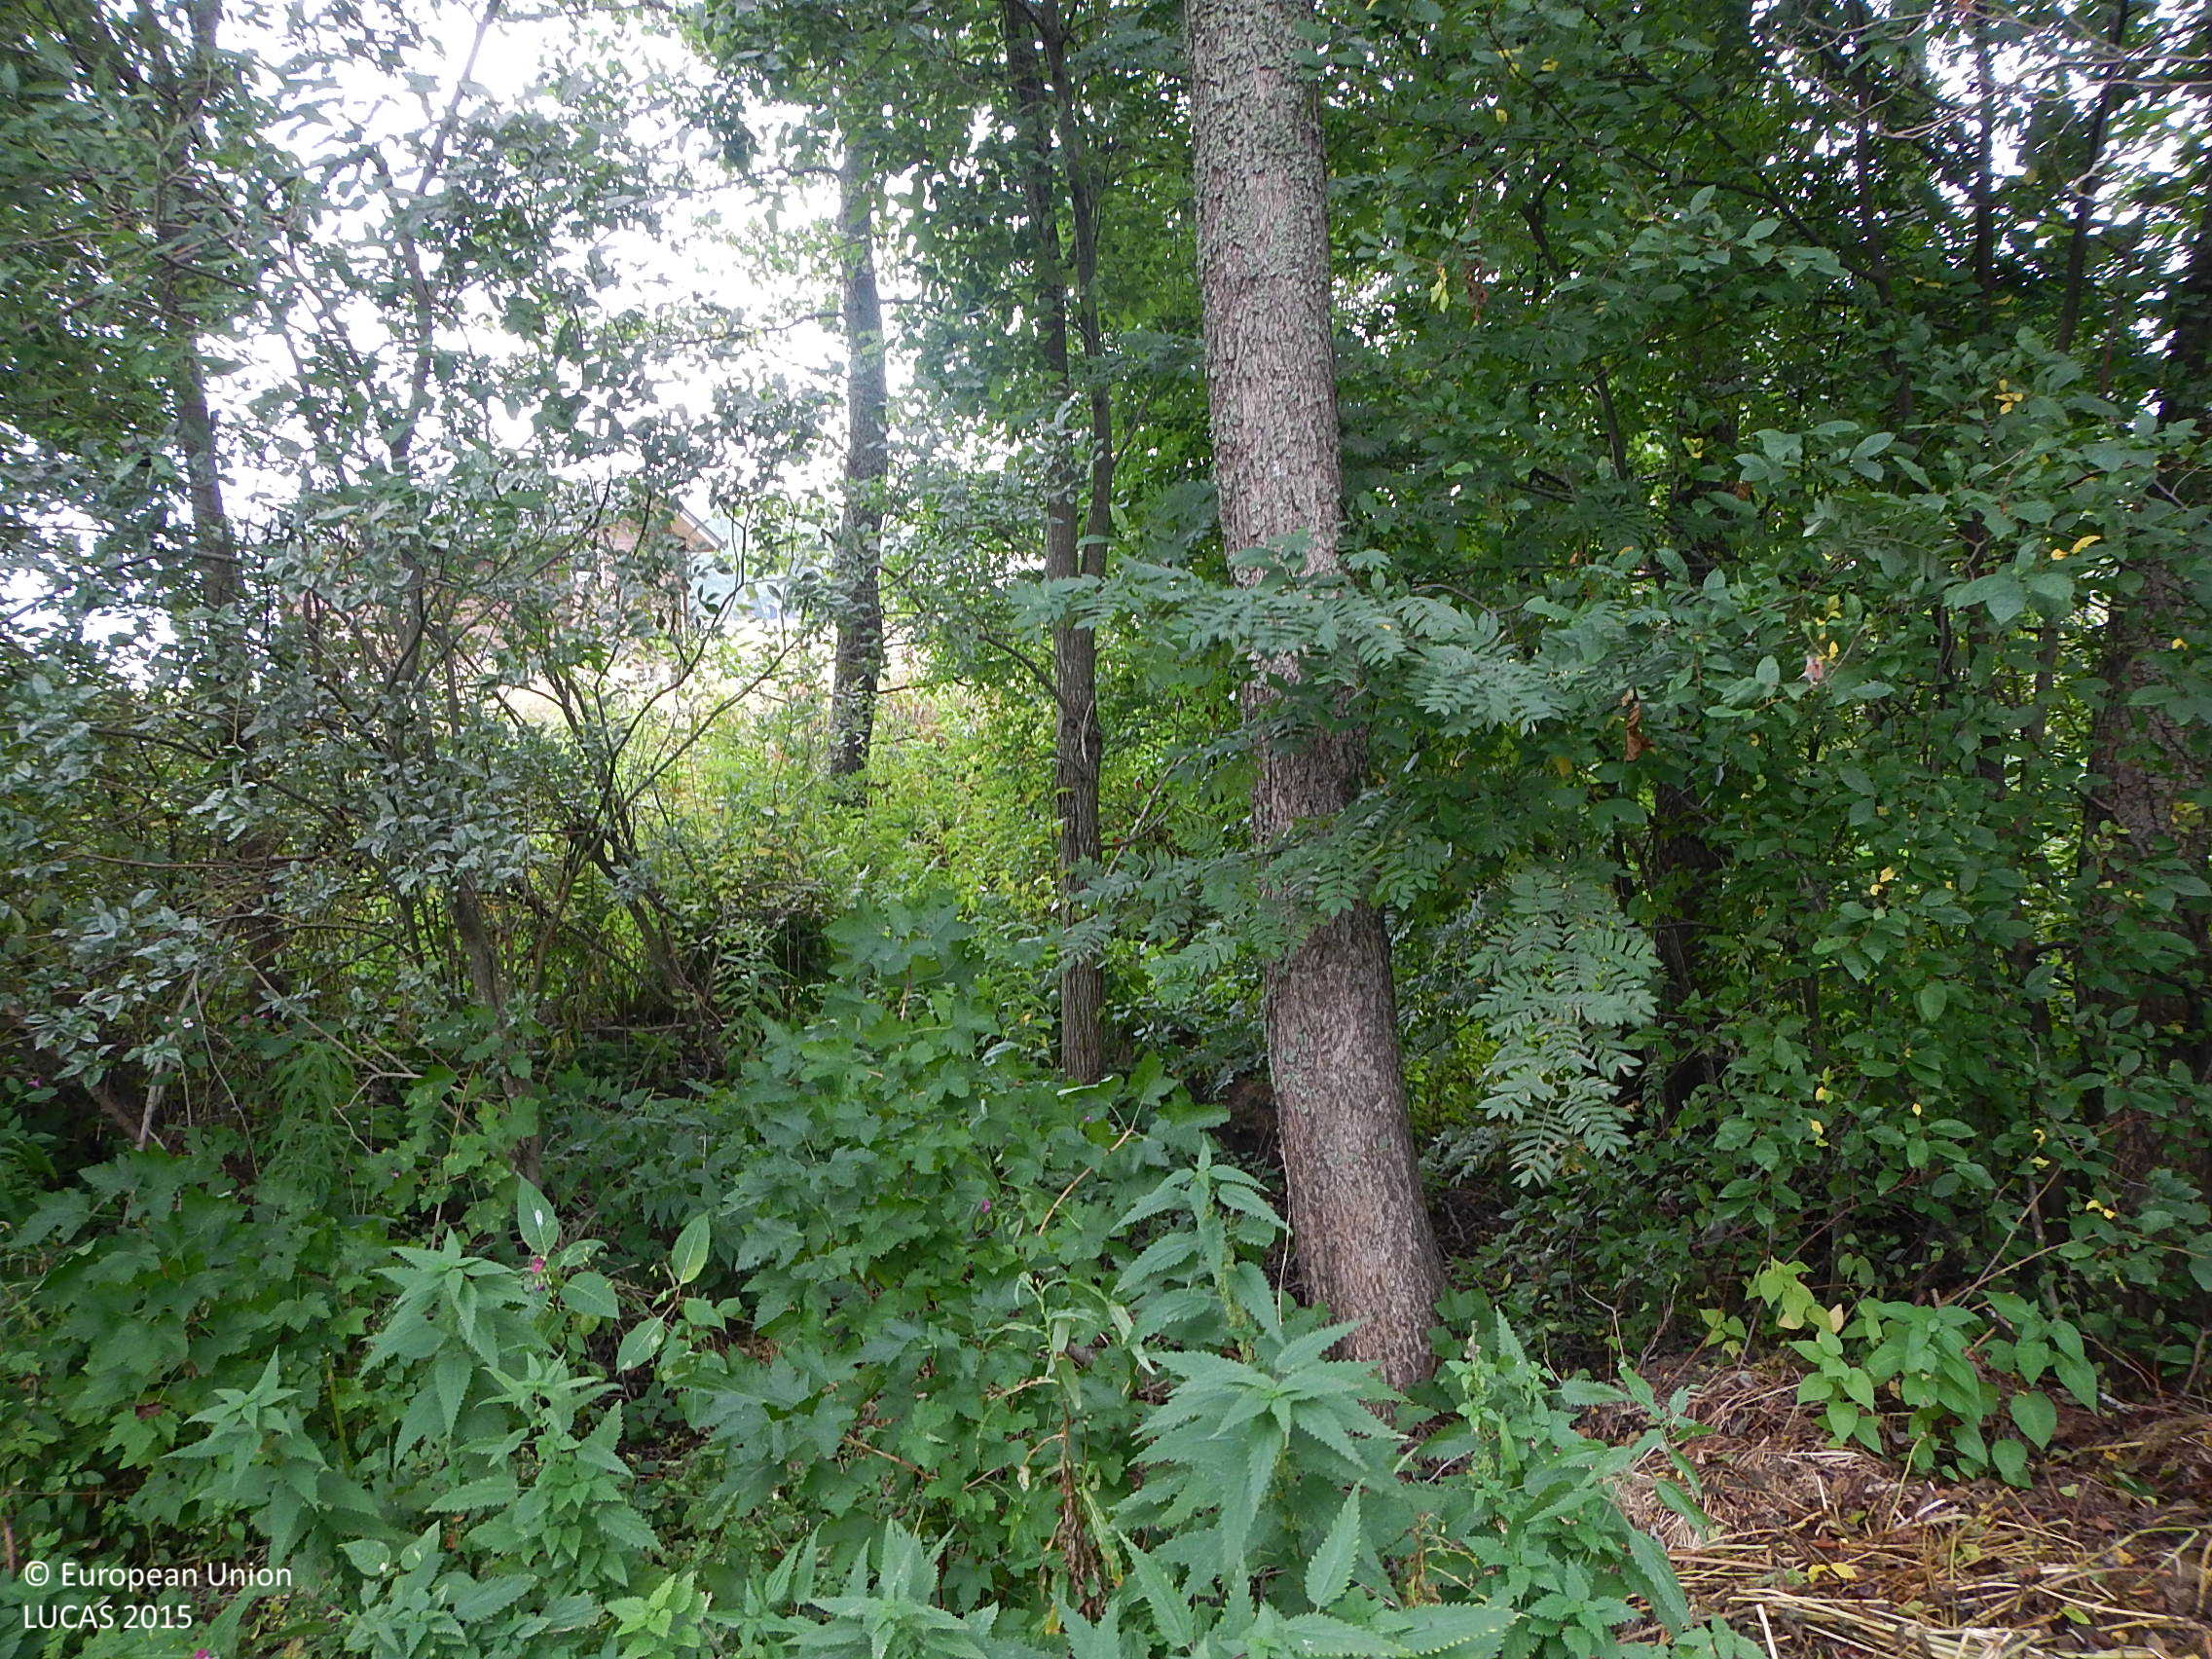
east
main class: Woodland
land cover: Broadleaved woodland
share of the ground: > 75 %
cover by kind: broadleaved forest trees 90 %, herbaceous plants 10 %
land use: Residential
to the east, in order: Broadleaved woodland; Ditches and canals; Broadleaved woodland; Spontaneously vegetated surfaces; Artificial constructions in urban areas; Sand; Spontaneously vegetated surfaces; Rock outcrops; Inland salty water bodies; Salt marshes; Single bushes/trees; Salt marshes; Inland salty water bodies; Salt marshes; Inland salty water bodies
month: September
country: FI
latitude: 61.6407
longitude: 21.5048
